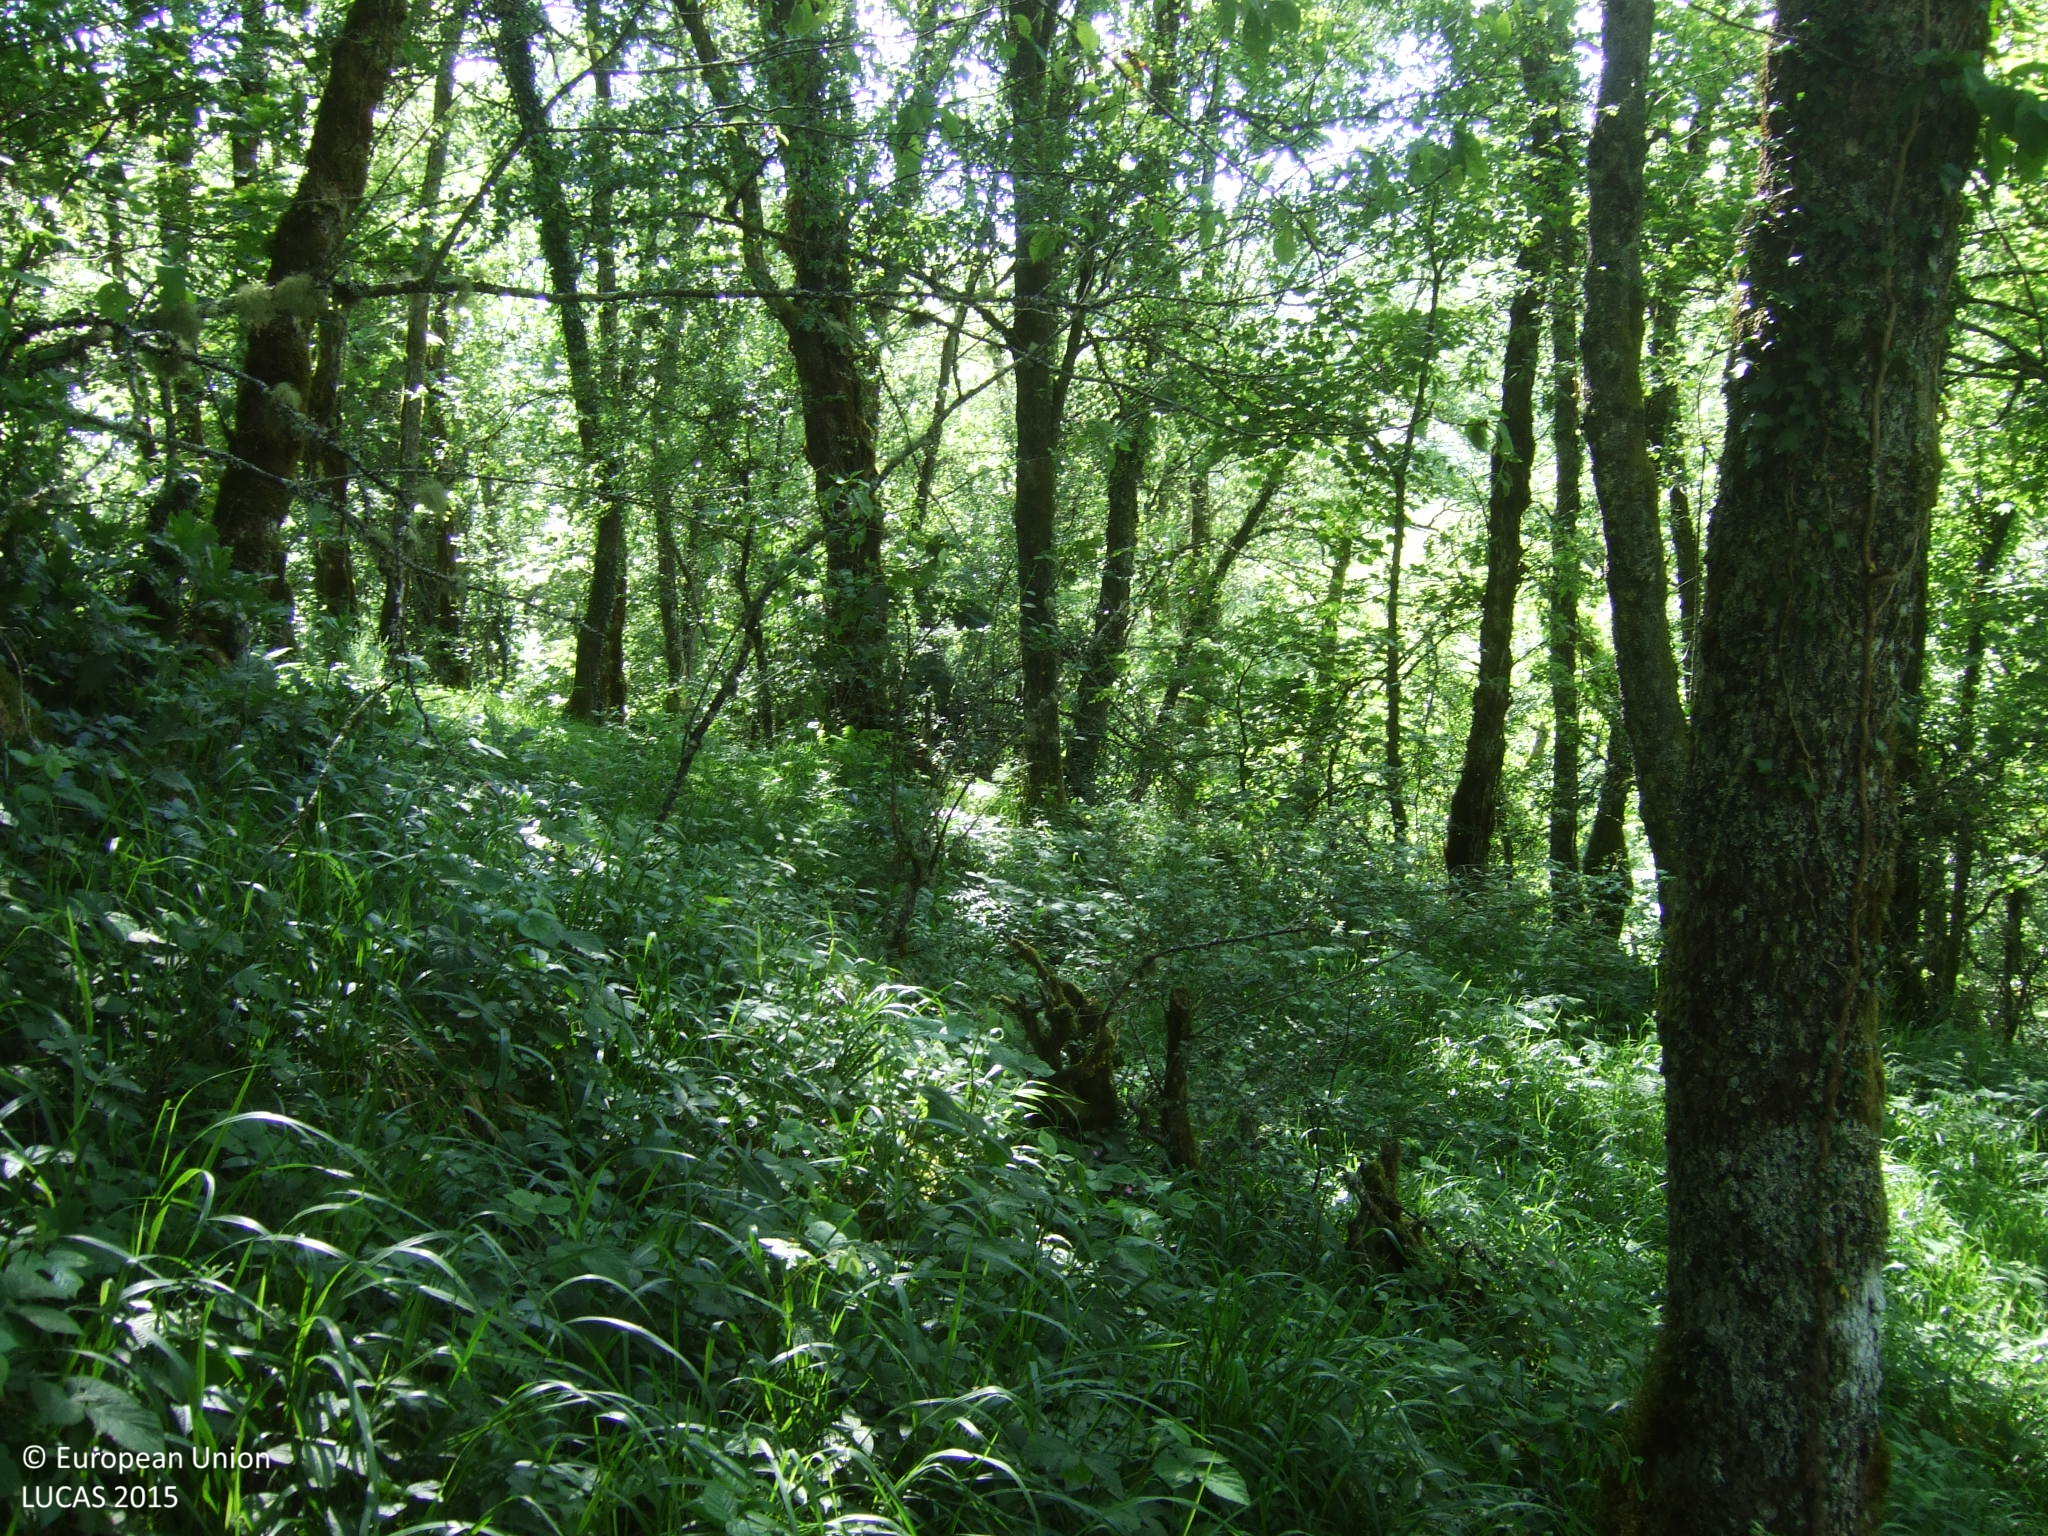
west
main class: Woodland
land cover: Broadleaved woodland
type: acidophilous oak and oak-birch forest
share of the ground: > 75 %
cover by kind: broadleaved forest trees 80 %, shrubs 20 %
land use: Semi-natural and natural areas not in use
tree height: > 5 m
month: June
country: ES
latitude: 42.6855
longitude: -7.0610
